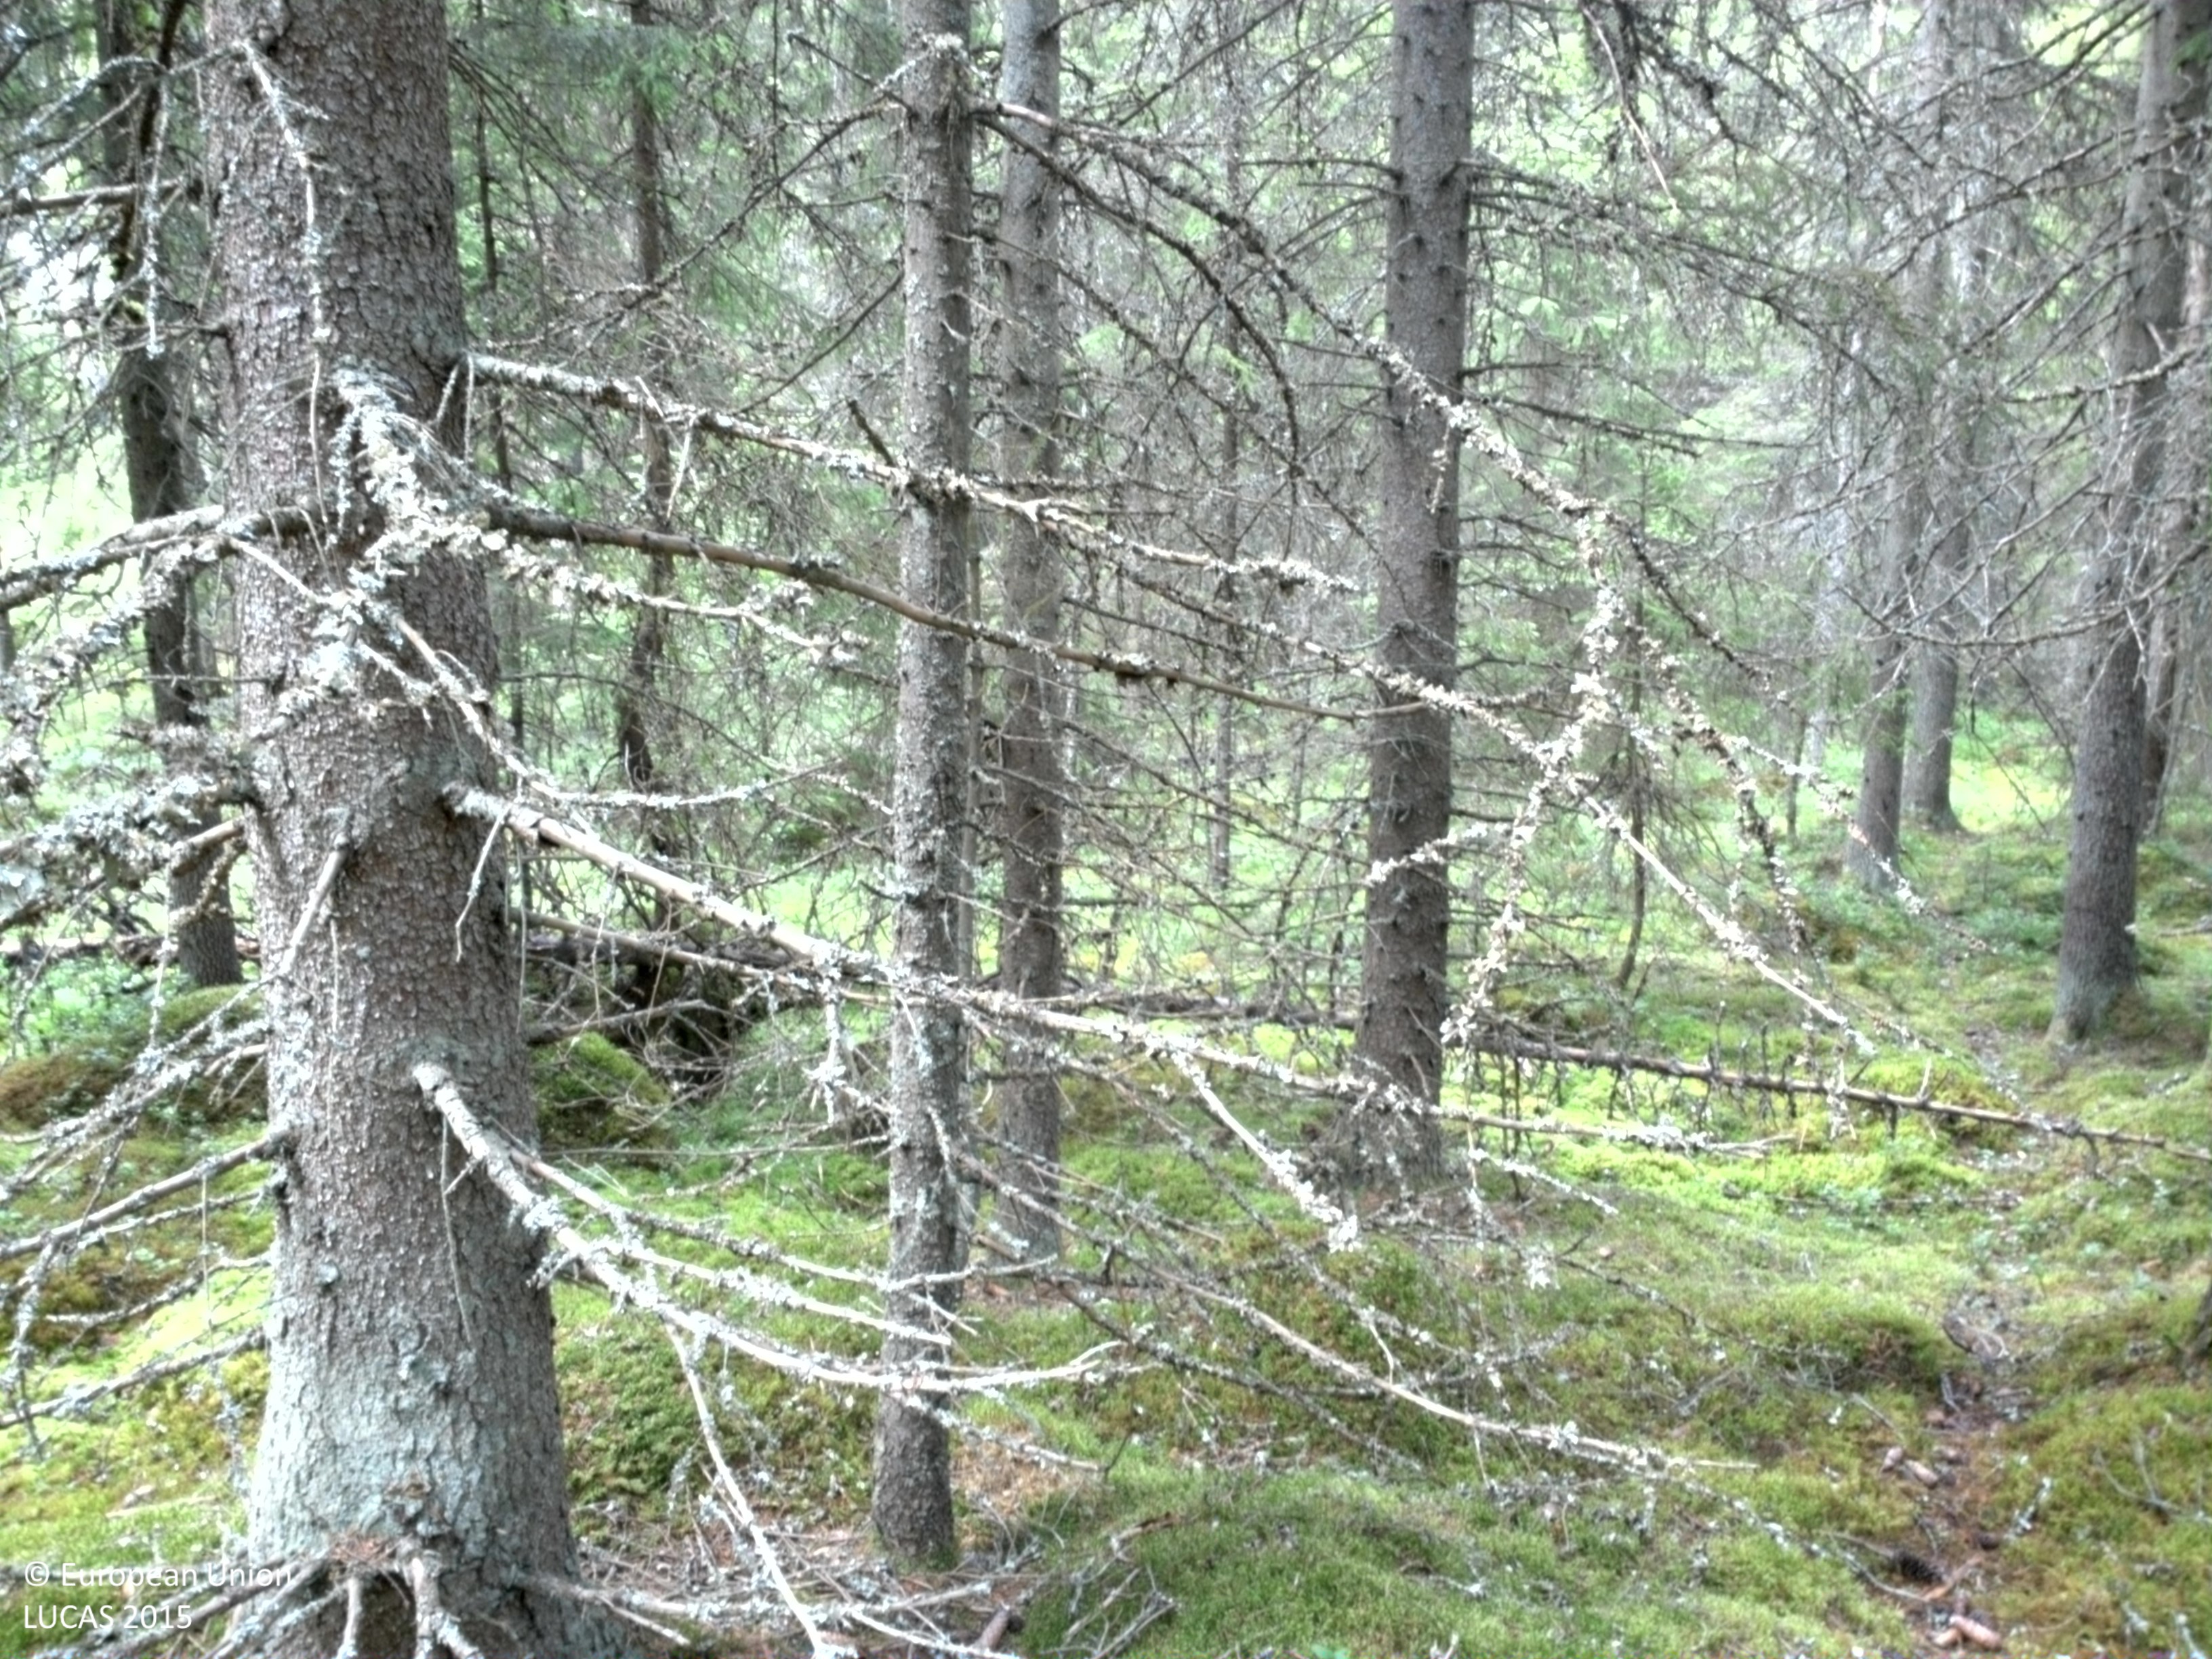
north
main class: Woodland
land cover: Spruce dominated coniferous woodland
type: boreal forest
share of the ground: > 75 %
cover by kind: coniferous forest trees 80 %, lichens and mosses 15 %, shrubs 5 %
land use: Forestry
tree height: > 5 m
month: July
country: SE
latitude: 57.6779
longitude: 14.4390
